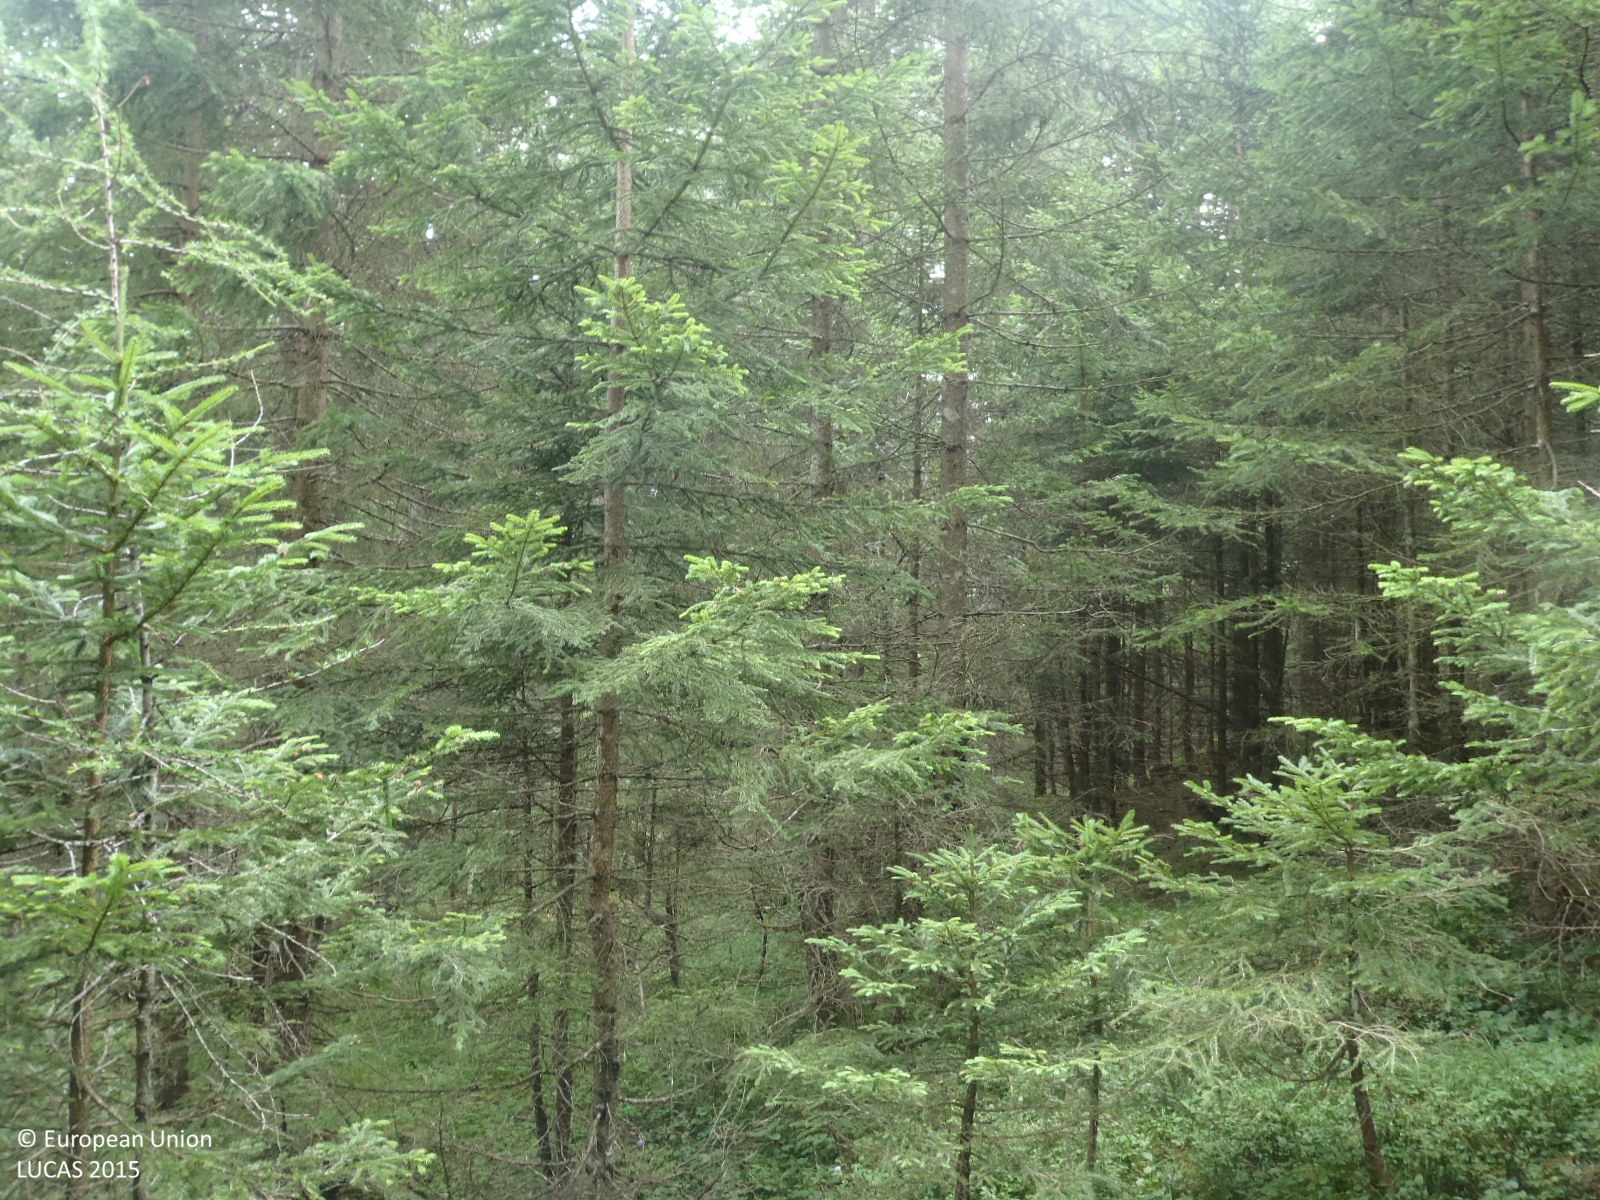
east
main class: Woodland
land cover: Other coniferous woodland
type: alpine coniferous forest
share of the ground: > 75 %
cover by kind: coniferous forest trees 80 %, herbaceous plants 15 %, shrubs 5 %
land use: Forestry
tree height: > 5 m
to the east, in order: Other coniferous woodland; Spruce dominated coniferous woodland; Other coniferous woodland; Grassland with sparse tree/shrub cover; Other coniferous woodland; Tracks; Other coniferous woodland
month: July
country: AT
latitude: 47.3020
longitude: 10.8853
